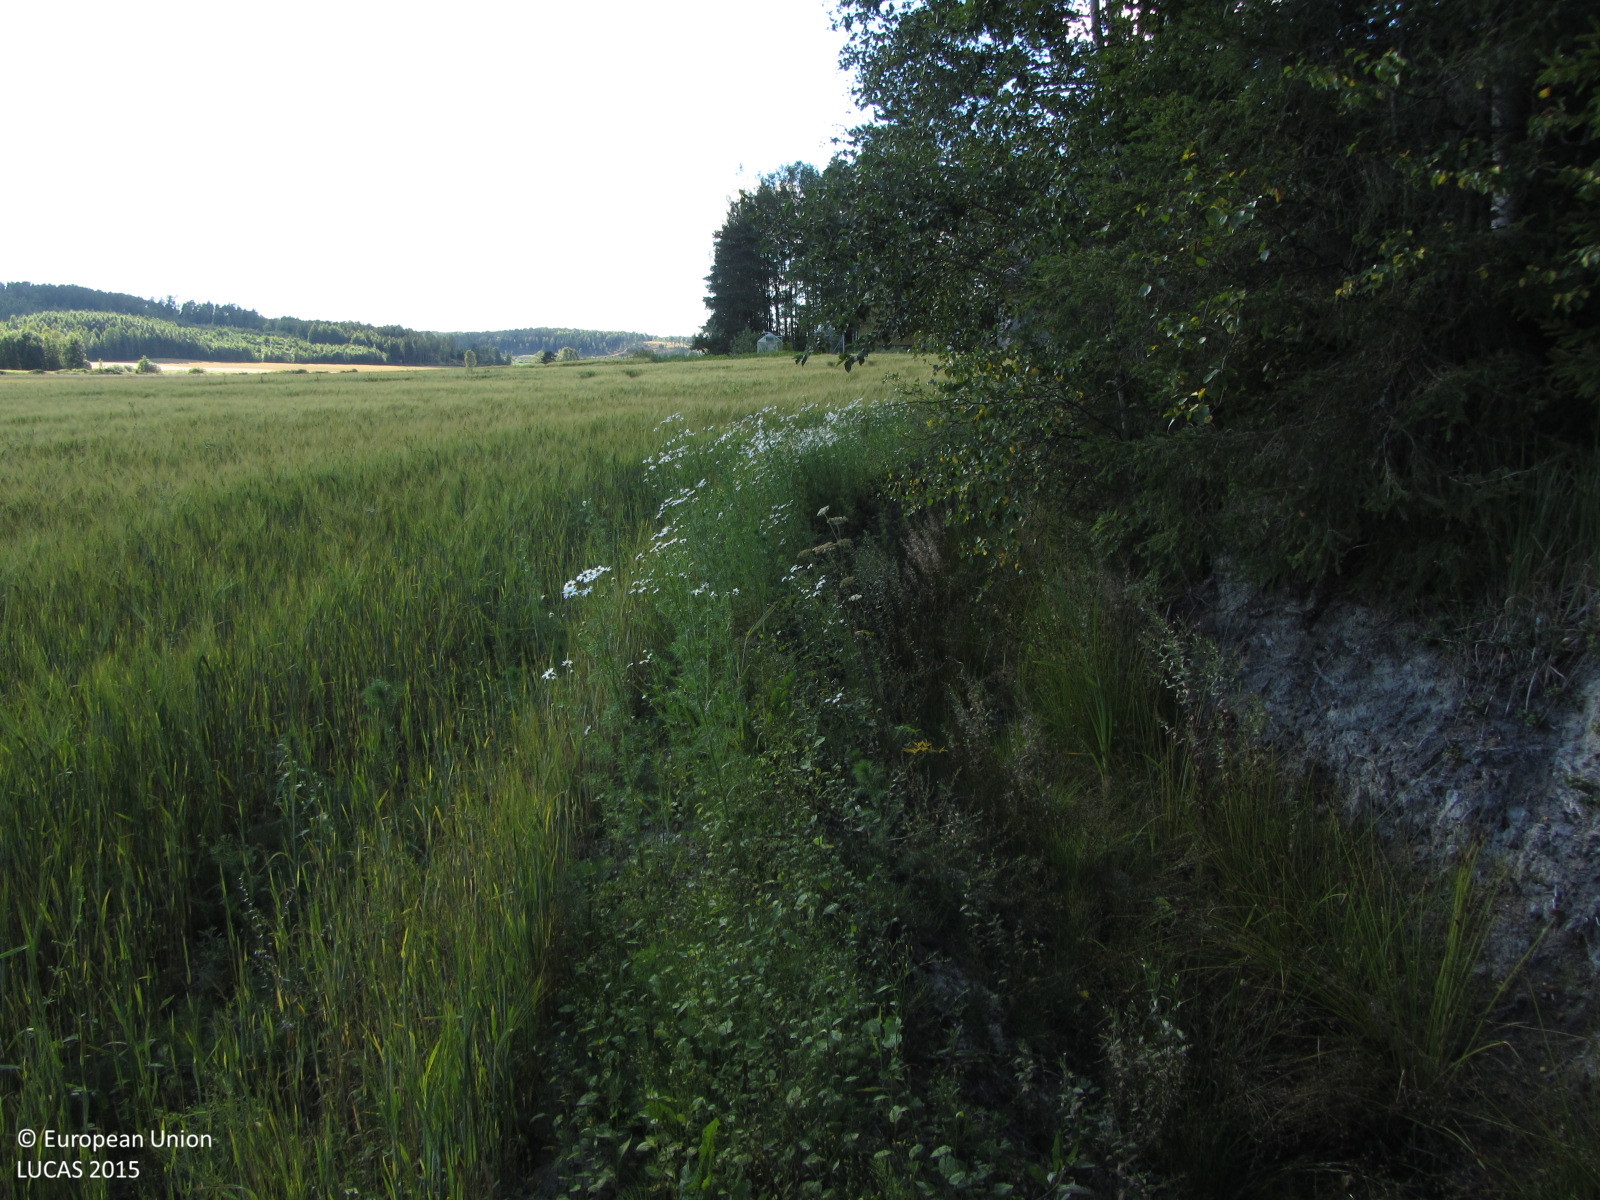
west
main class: Cropland
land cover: Barley
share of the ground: > 75 %
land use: Agriculture (excluding fallow land and kitchen gardens)
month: August
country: FI
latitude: 60.4771
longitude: 23.9026
